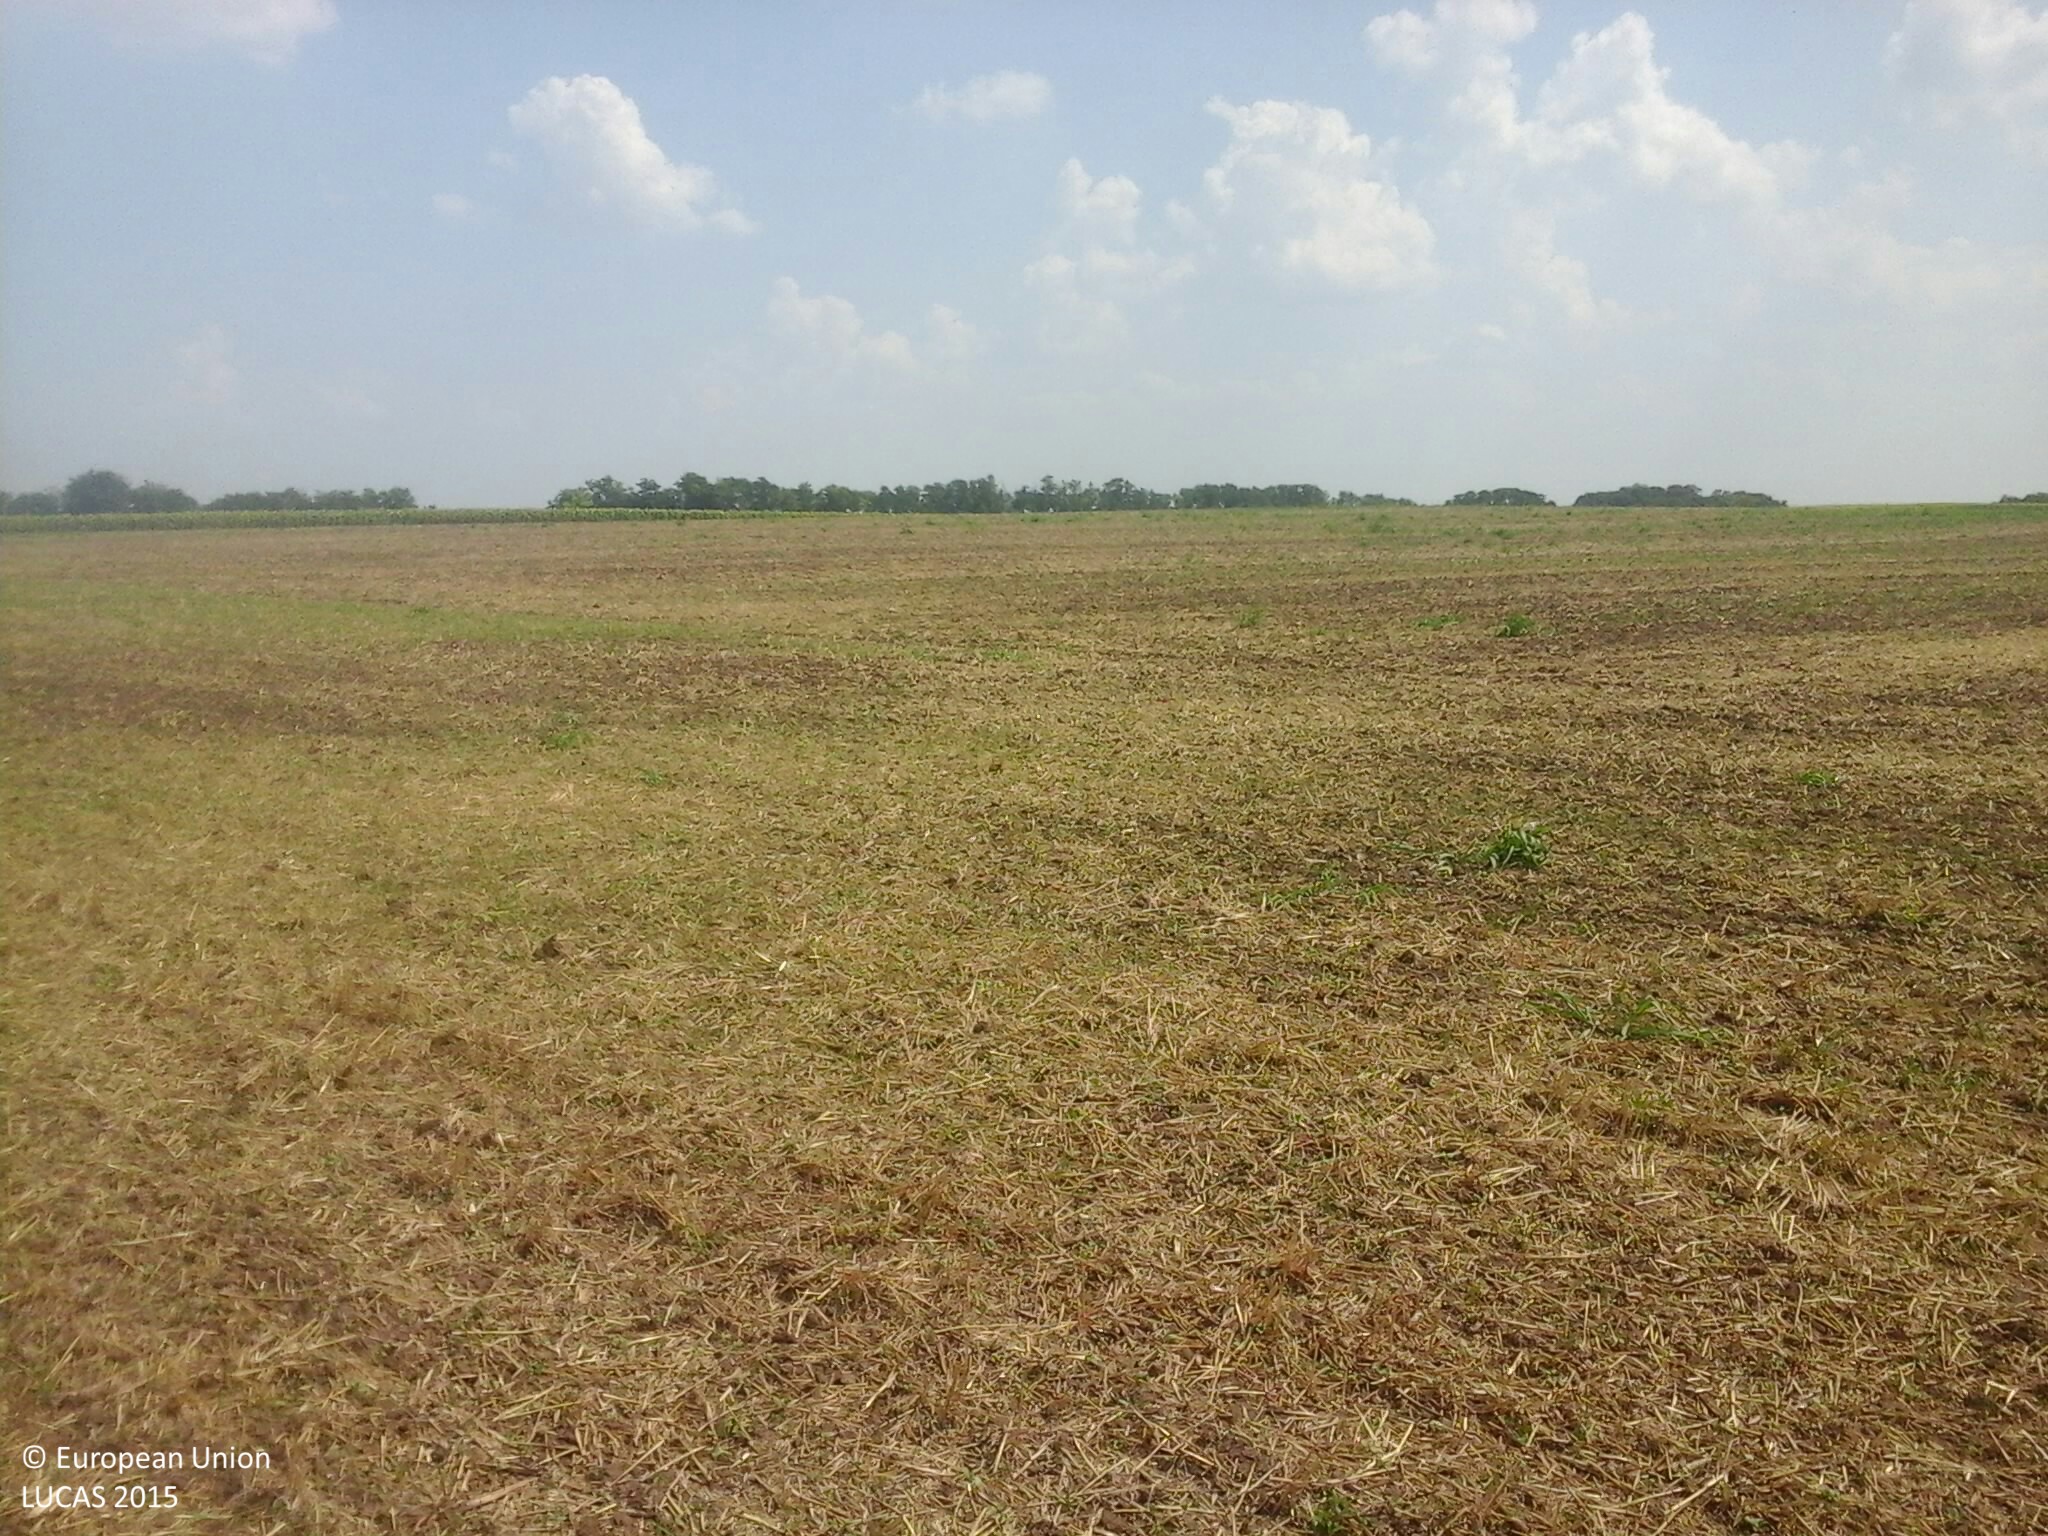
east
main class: Cropland
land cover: Common wheat
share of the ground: < 10 %
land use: Agriculture (excluding fallow land and kitchen gardens)
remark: Harvested field
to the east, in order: Common wheat; Sunflower
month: August
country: HU
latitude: 46.8797
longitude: 18.2902
